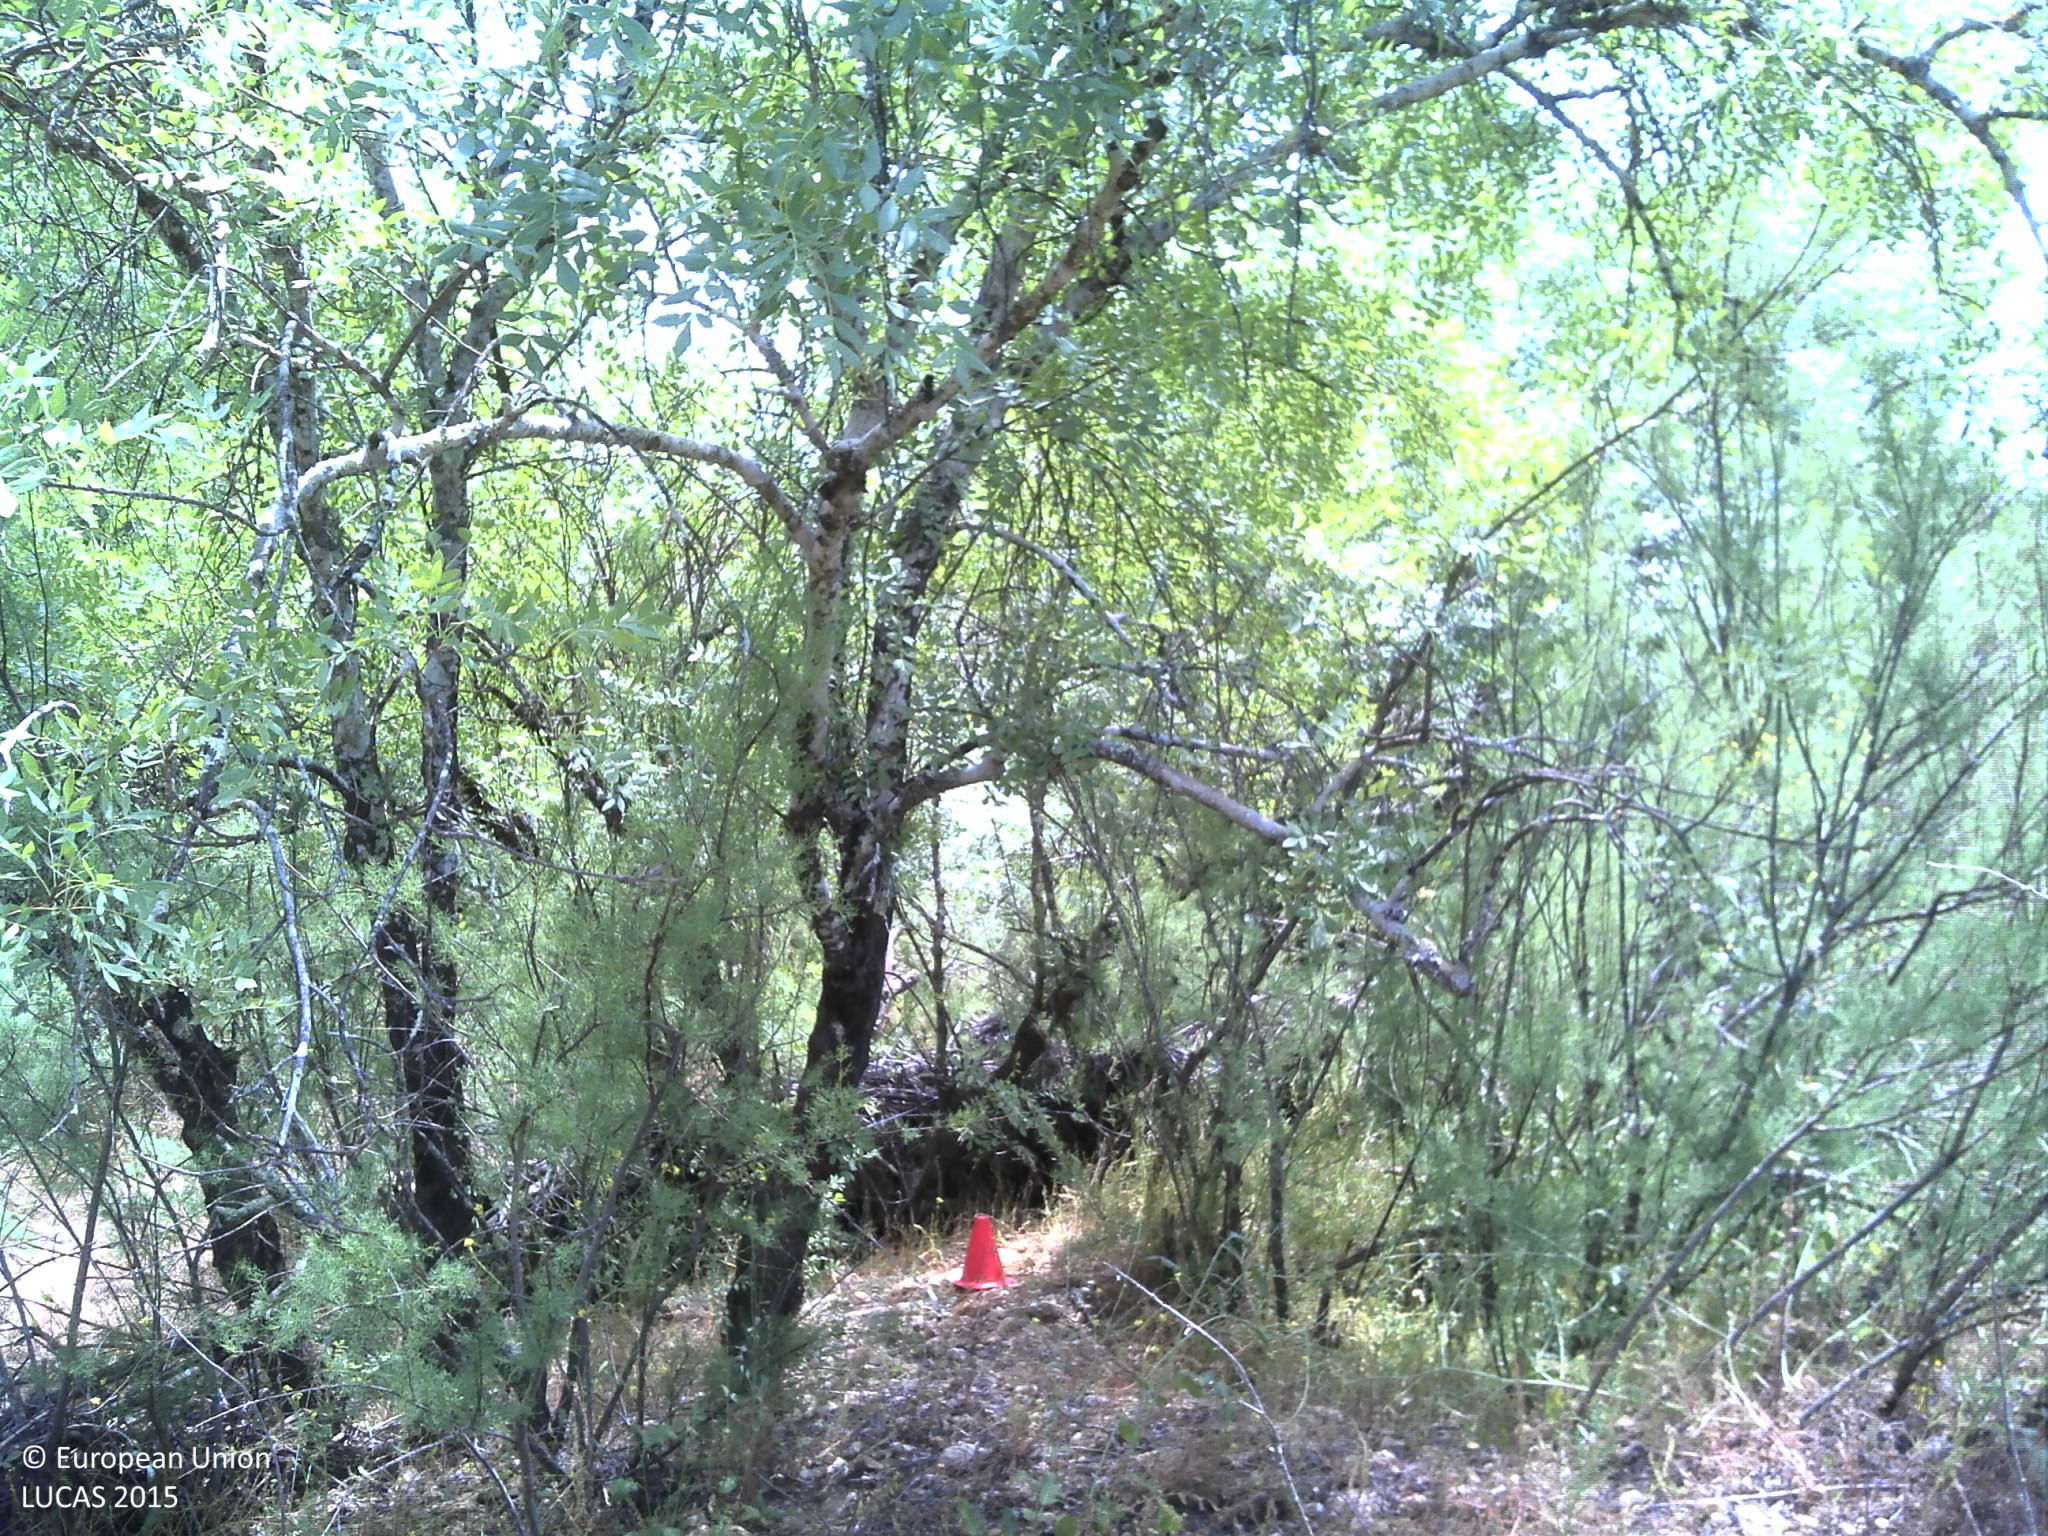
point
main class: Woodland
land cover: Broadleaved woodland
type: floodplain forest
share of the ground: 50 - 75 %
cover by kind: broadleaved forest trees 50 %, shrubs 25 %, unconsolidated bare surface 15 %, herbaceous plants 10 %
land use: Semi-natural and natural areas not in use
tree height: > 5 m
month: May
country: PT
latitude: 38.0342
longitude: -8.3722
